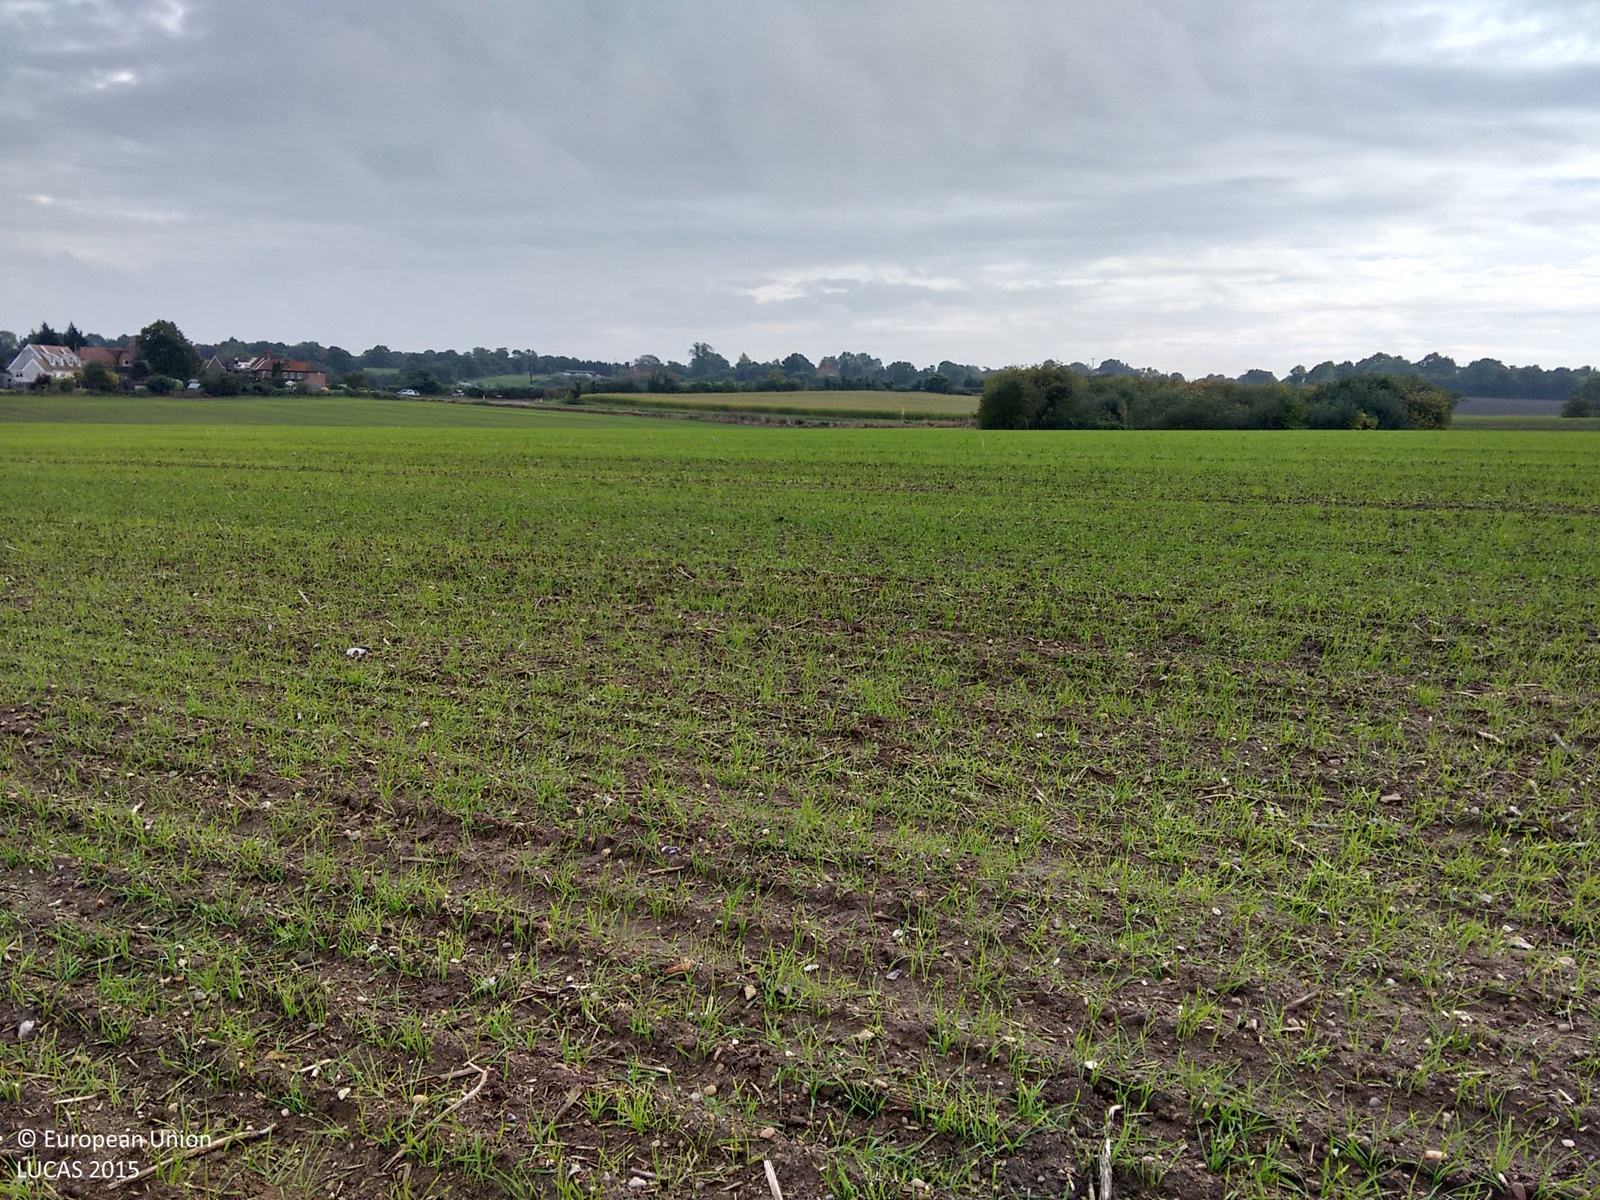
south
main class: Cropland
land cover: Common wheat
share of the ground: 10 - 25 %
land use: Agriculture (excluding fallow land and kitchen gardens)
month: October
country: GB
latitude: 52.4533
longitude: 1.5198
